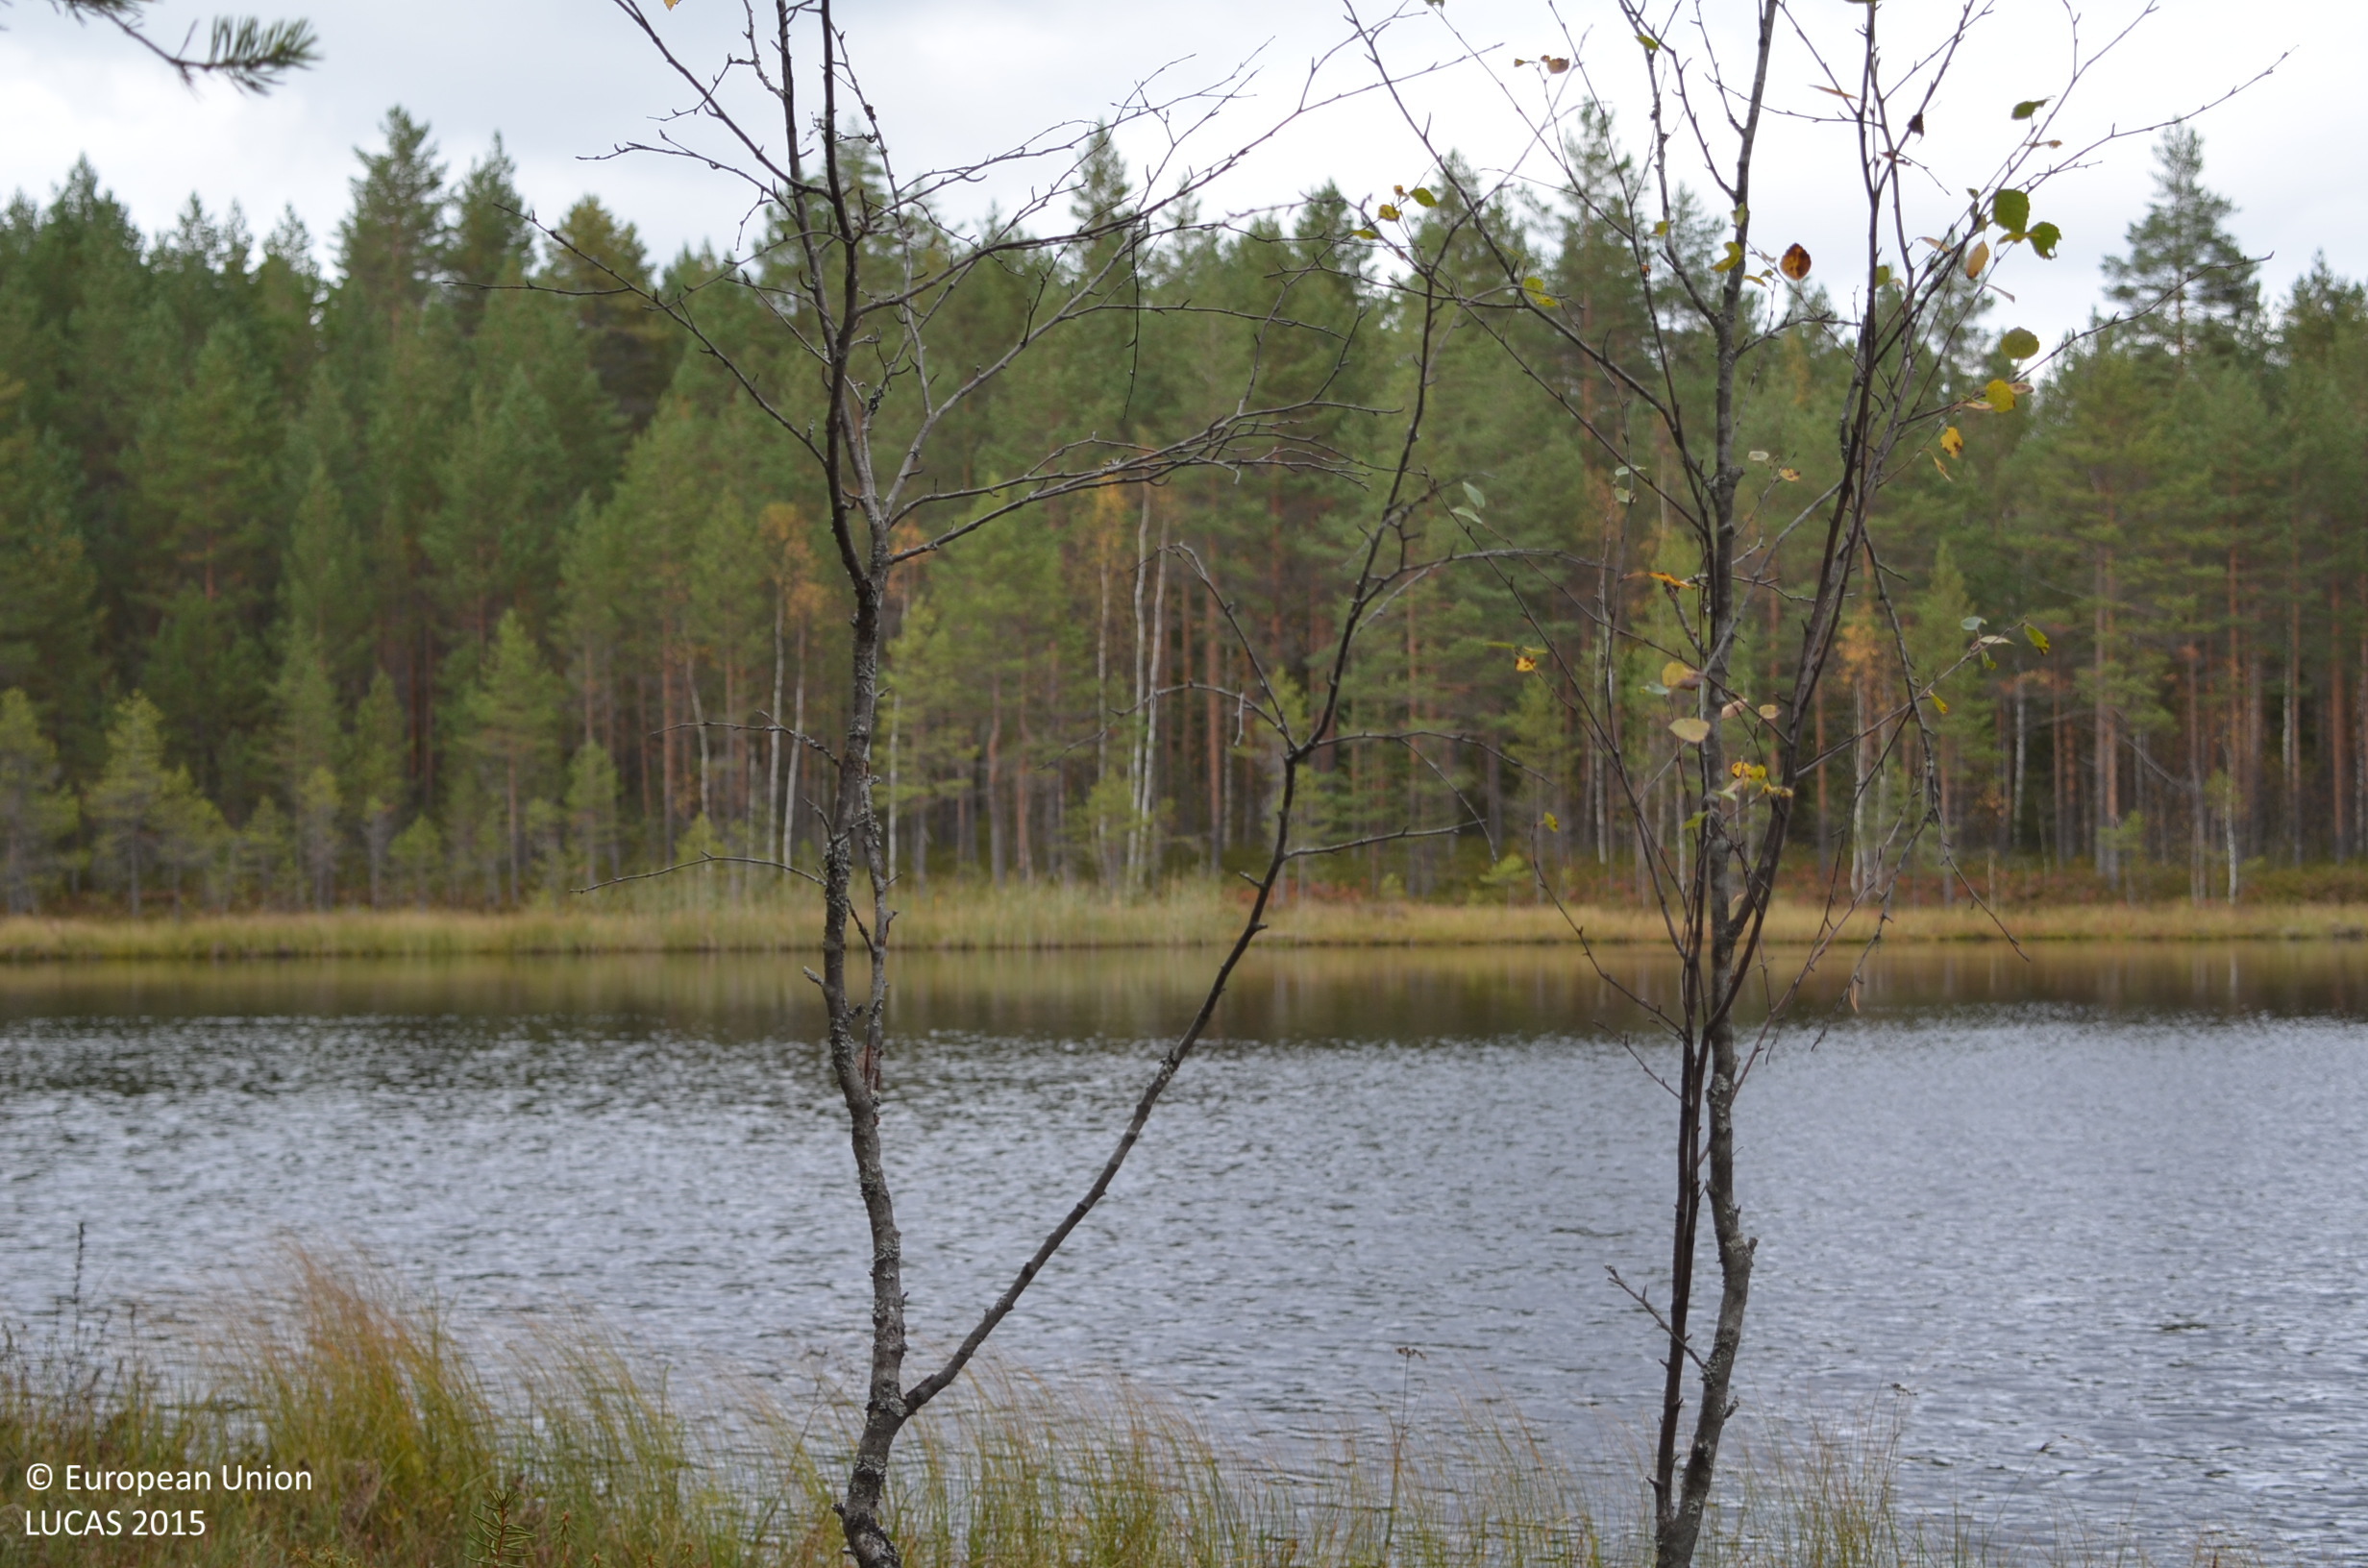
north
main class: Woodland
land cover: Pine dominated mixed woodland
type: boreal forest
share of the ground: 50 - 75 %
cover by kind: coniferous forest trees 50 %, shrubs 25 %, broadleaved forest trees 20 %, lichens and mosses 5 %
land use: Forestry
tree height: > 5 m
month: September
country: FI
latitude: 62.4308
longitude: 23.6116
